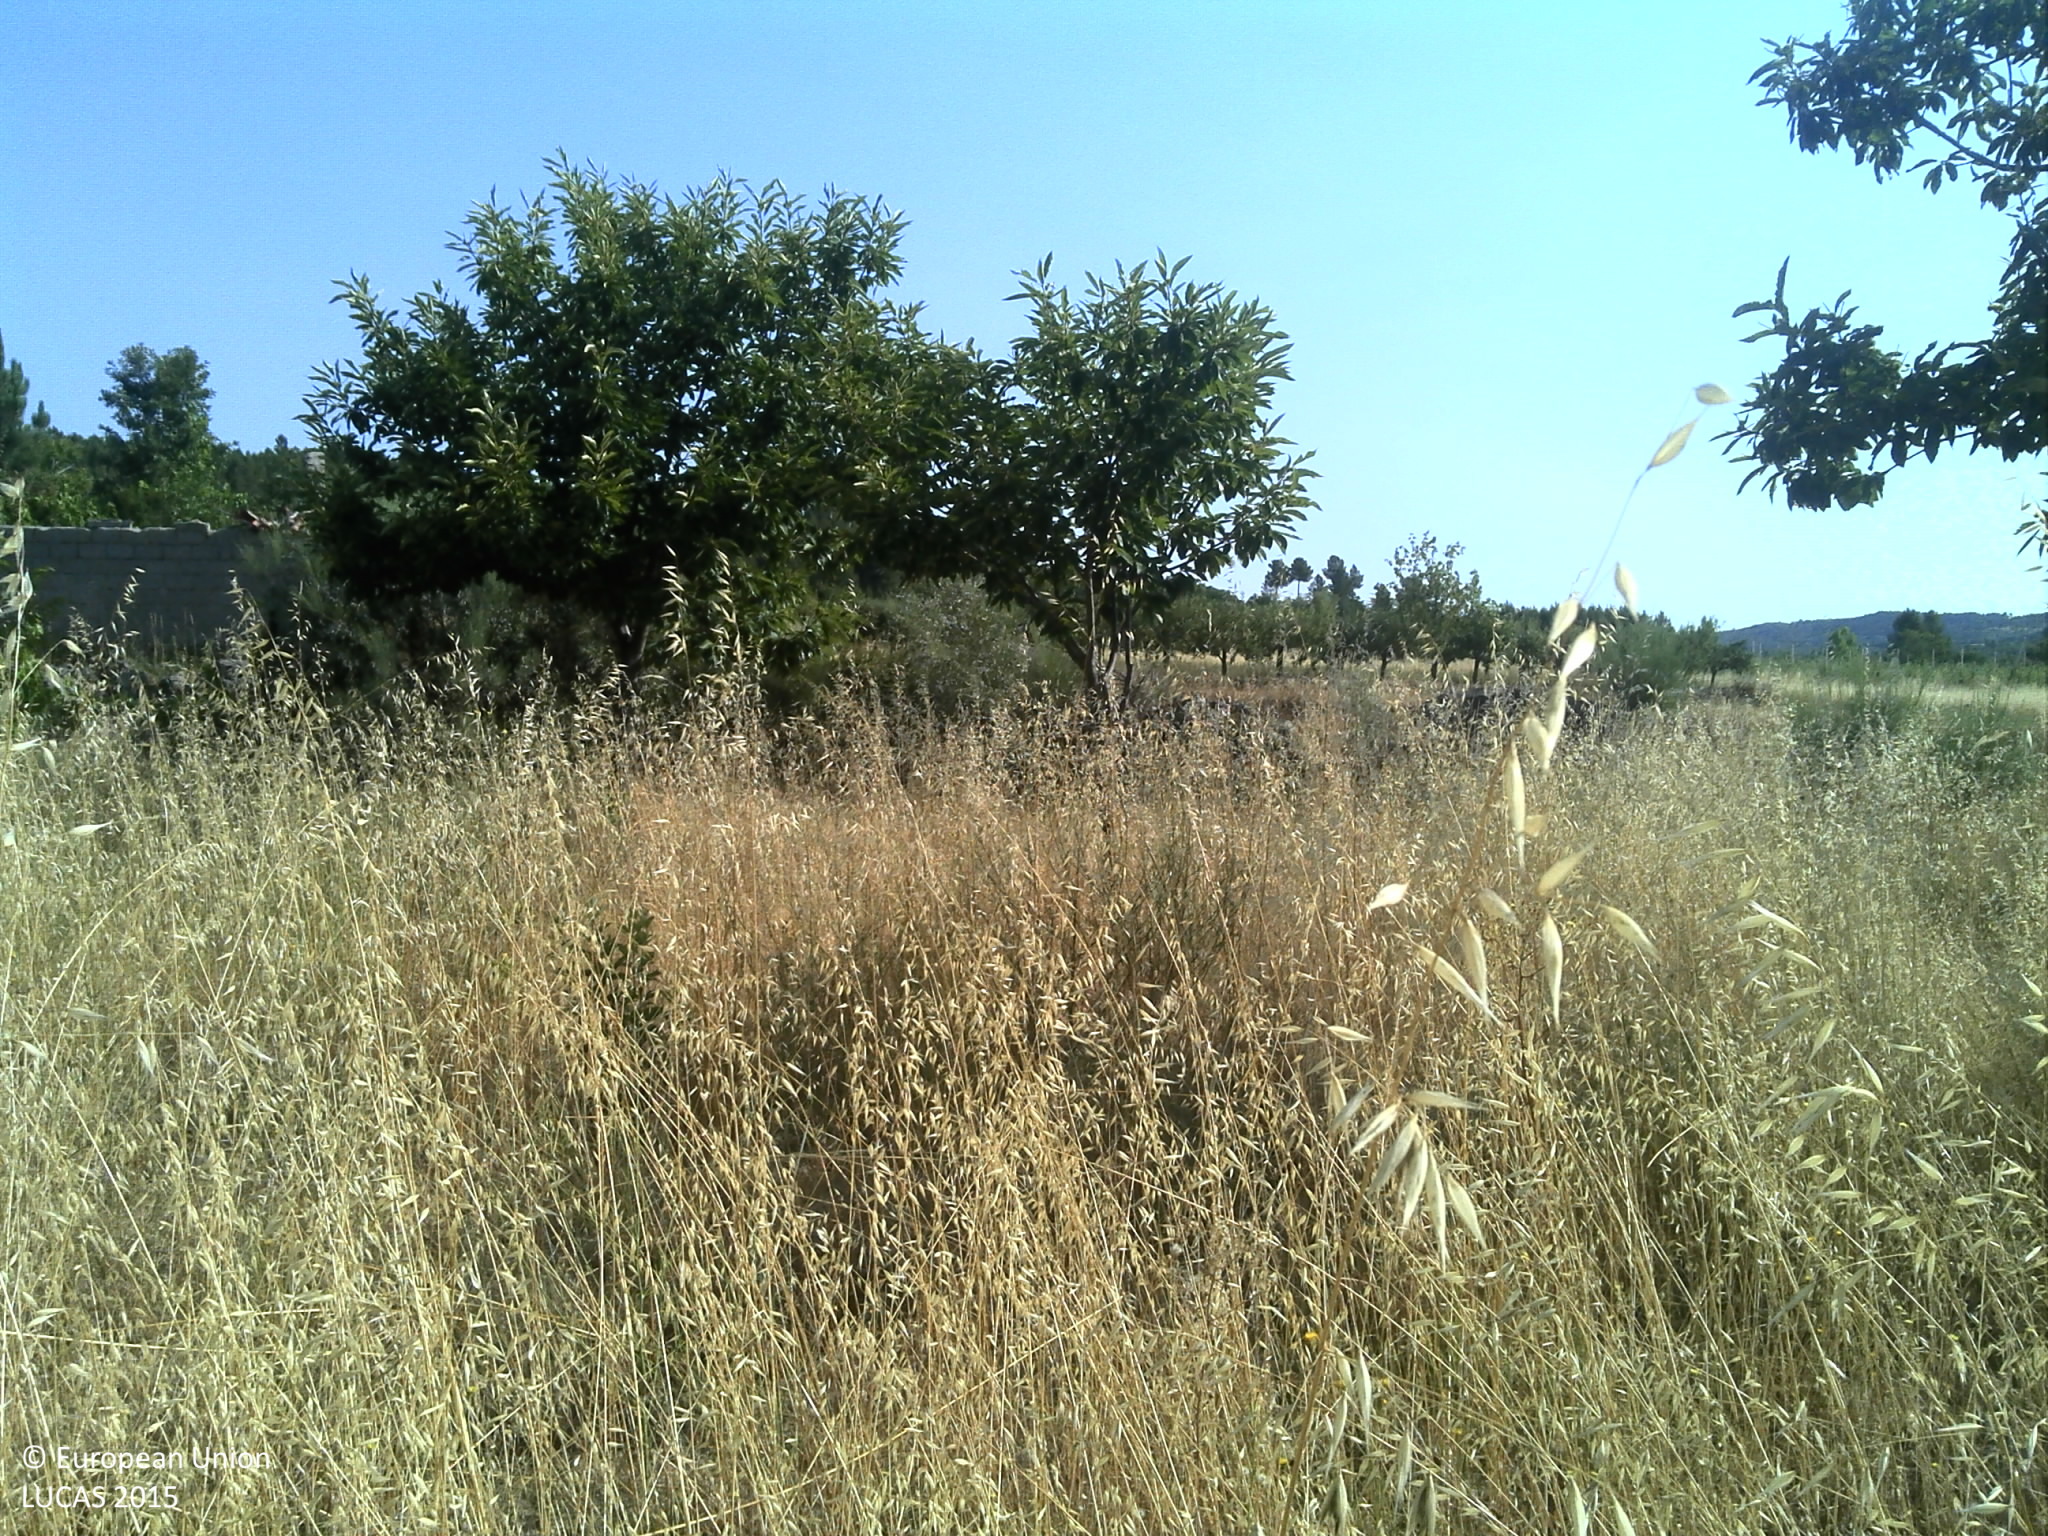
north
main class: Cropland
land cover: Nuts trees
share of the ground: < 10 %
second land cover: Spontaneously vegetated surfaces
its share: 50 - 75 %
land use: Agriculture (excluding fallow land and kitchen gardens)
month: July
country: PT
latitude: 40.9456
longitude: -7.4238
